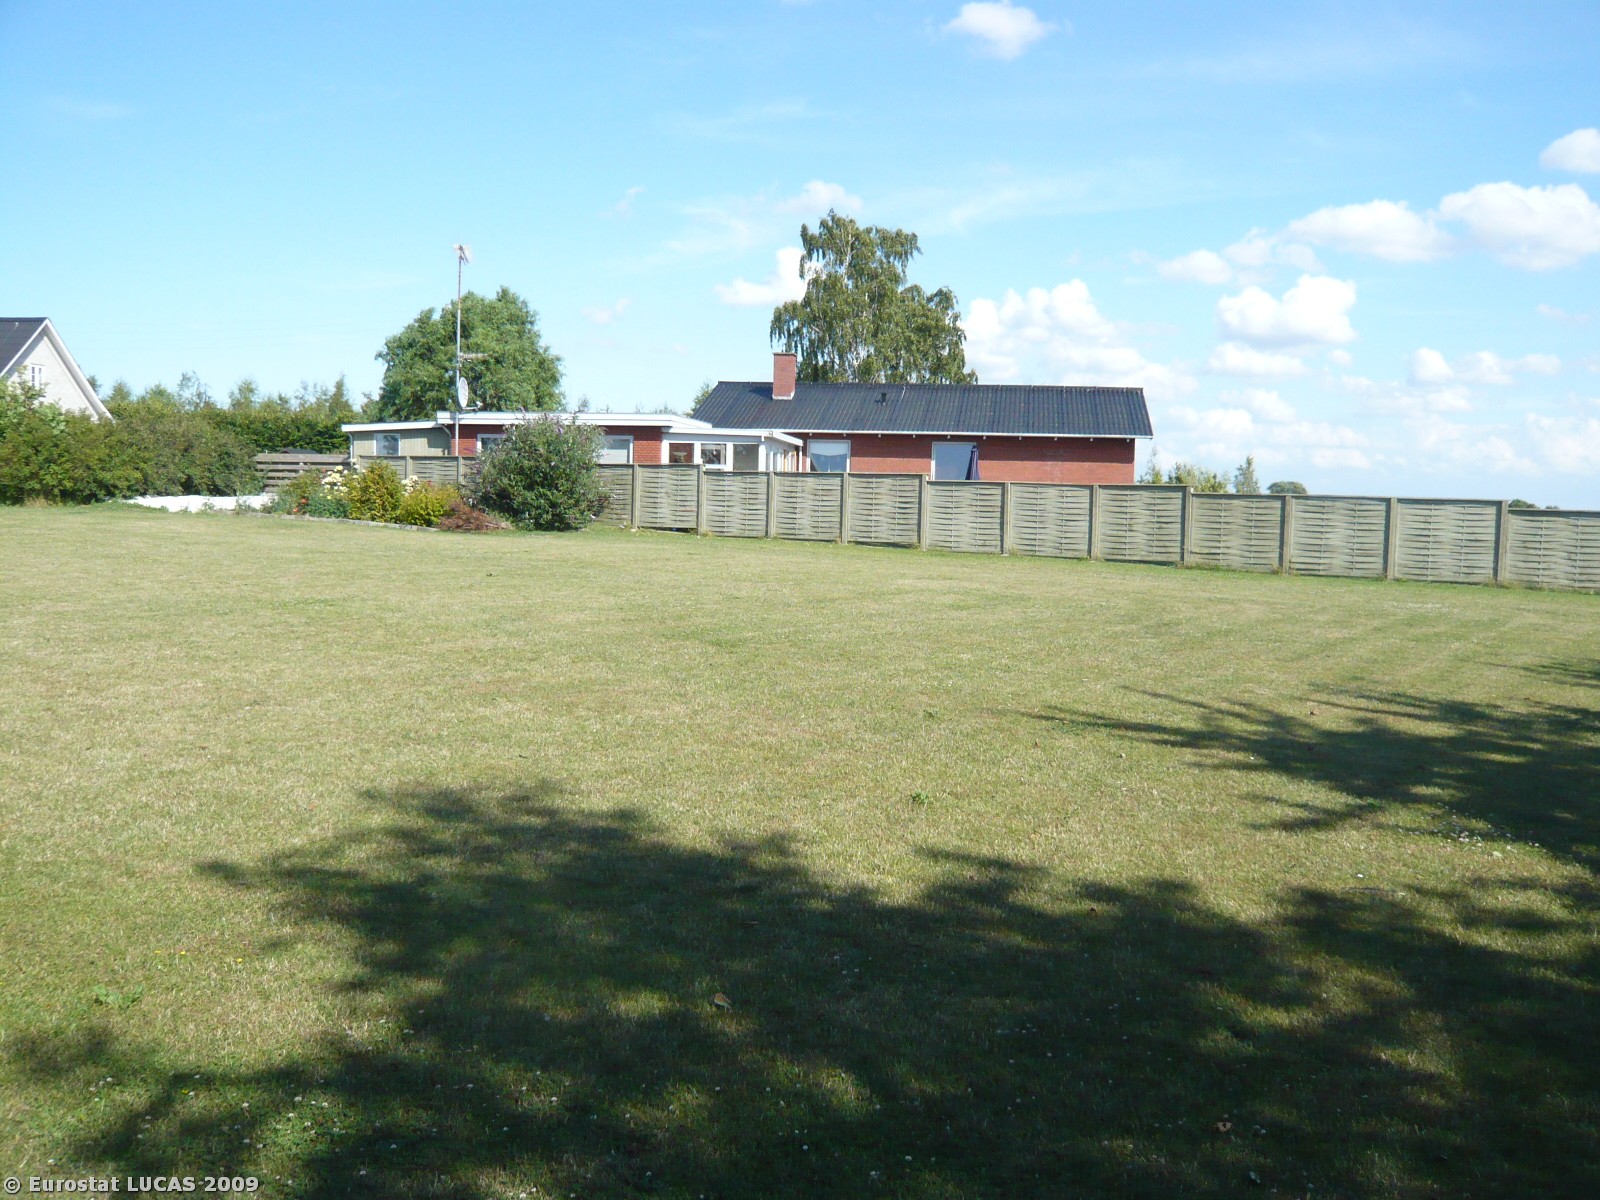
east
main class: Grassland
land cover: Grassland without tree/shrub cover
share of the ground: > 75 %
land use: Residential
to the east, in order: Grassland without tree/shrub cover; Artificial constructions in urban areas
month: July
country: DK
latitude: 55.7462
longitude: 11.6074
